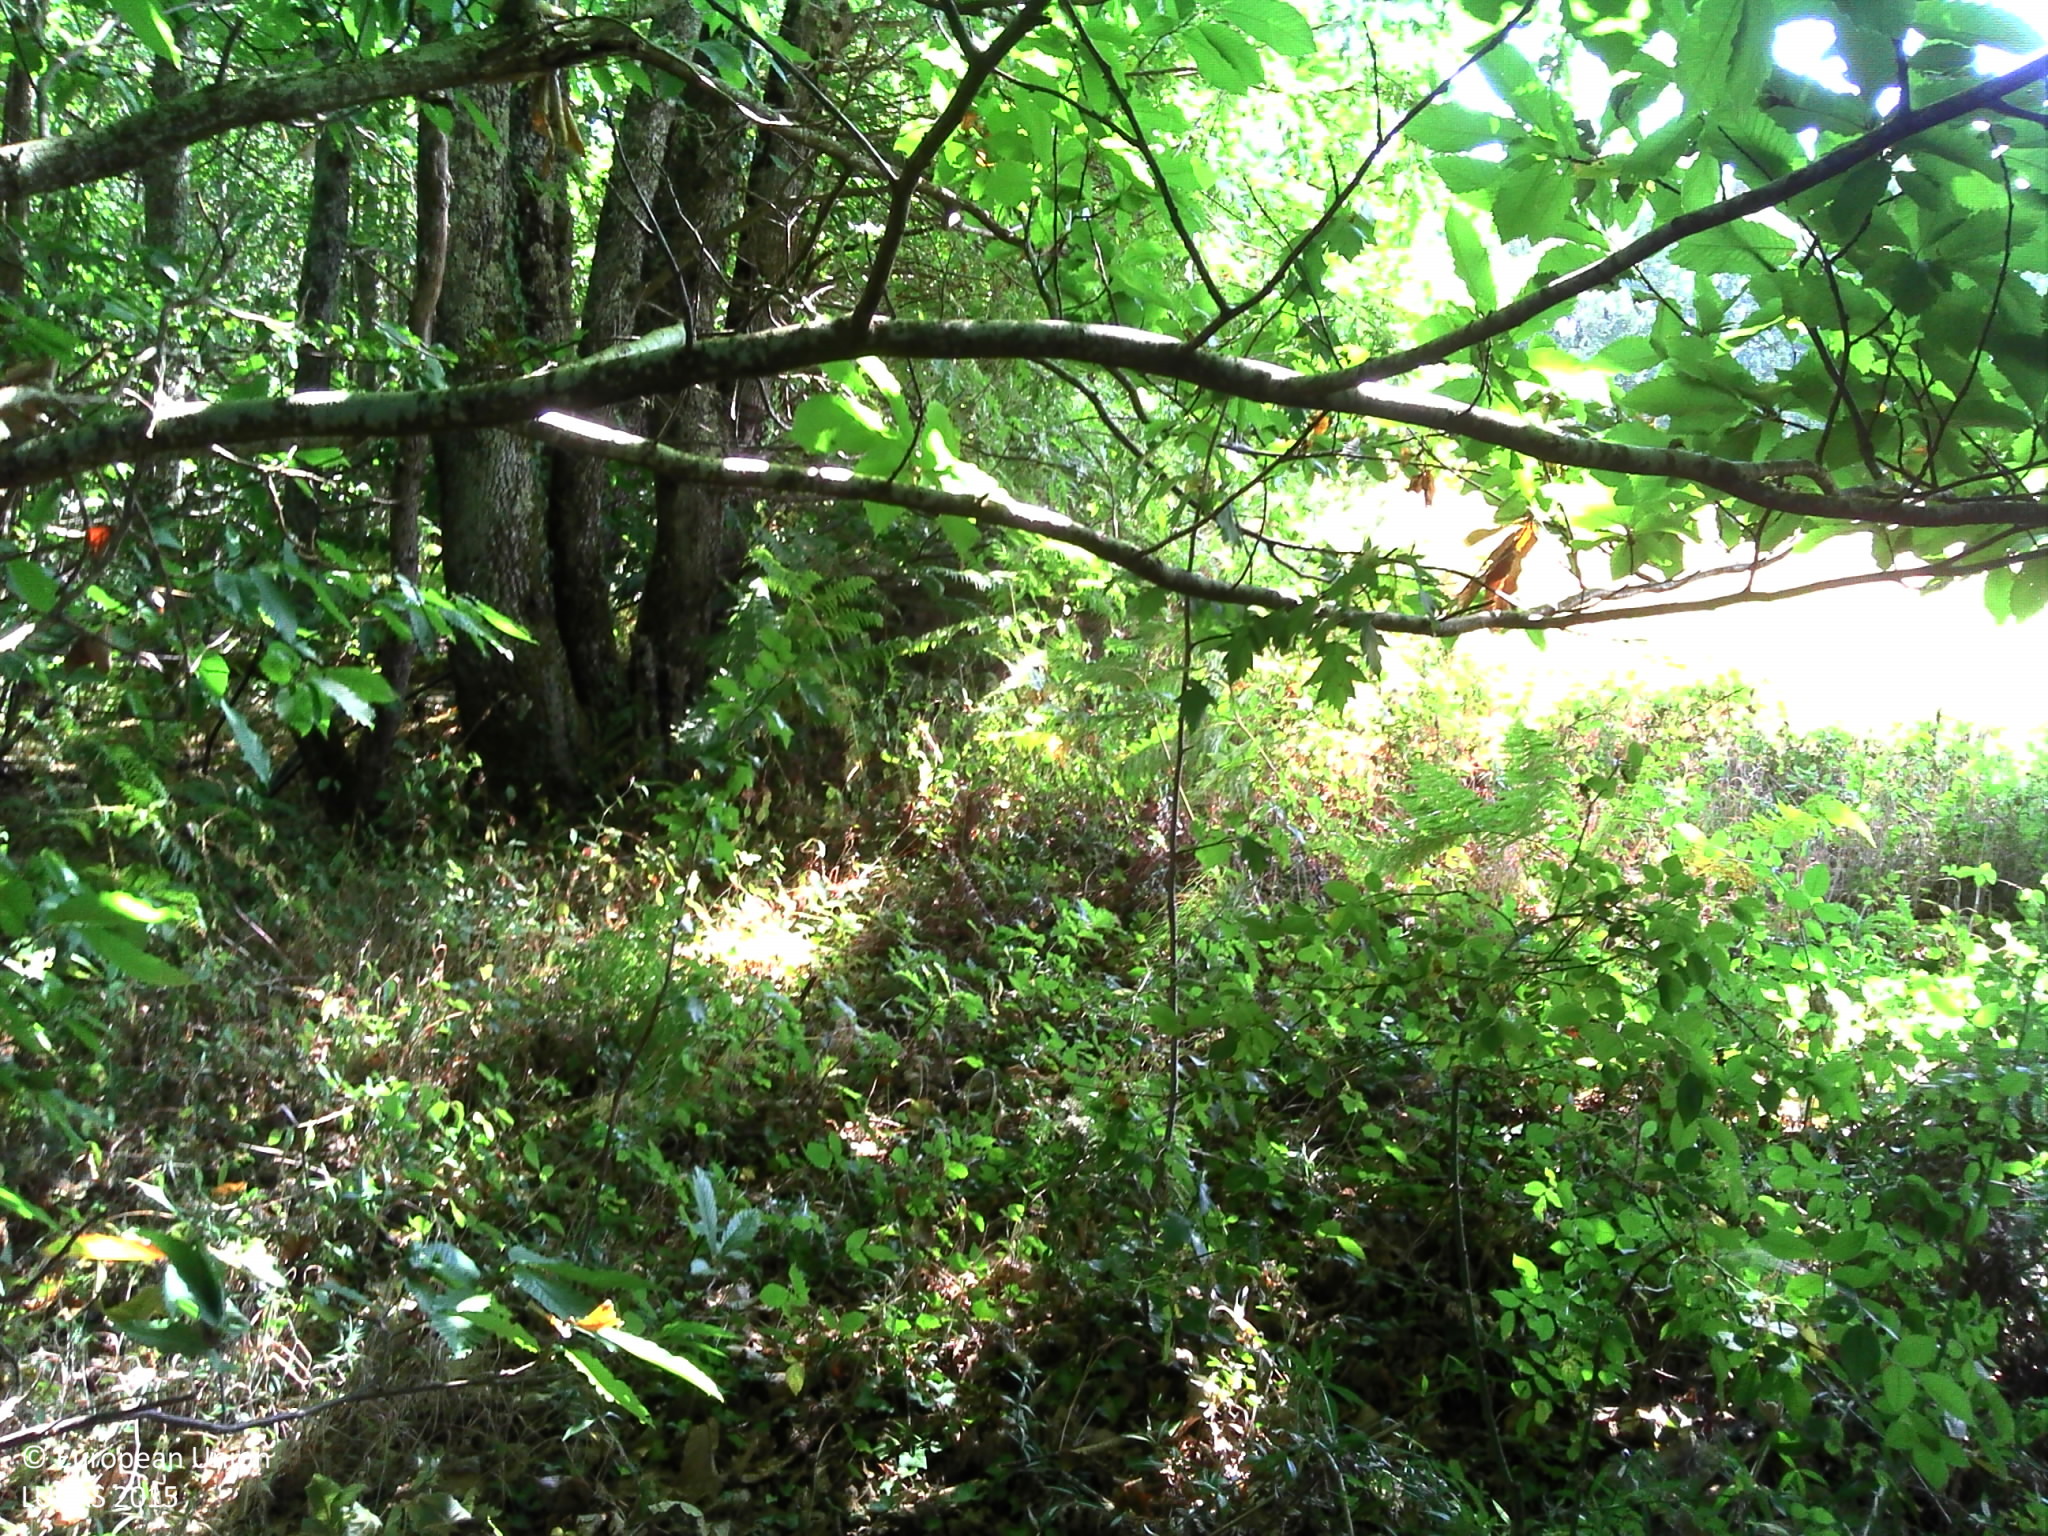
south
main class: Woodland
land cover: Broadleaved woodland
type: thermophilous deciduous forest
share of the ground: > 75 %
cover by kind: broadleaved forest trees 80 %, herbaceous plants 10 %, coniferous forest trees 5 %, shrubs 5 %
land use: Forestry
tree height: > 5 m
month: July
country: FR
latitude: 45.0775
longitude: 0.5256
